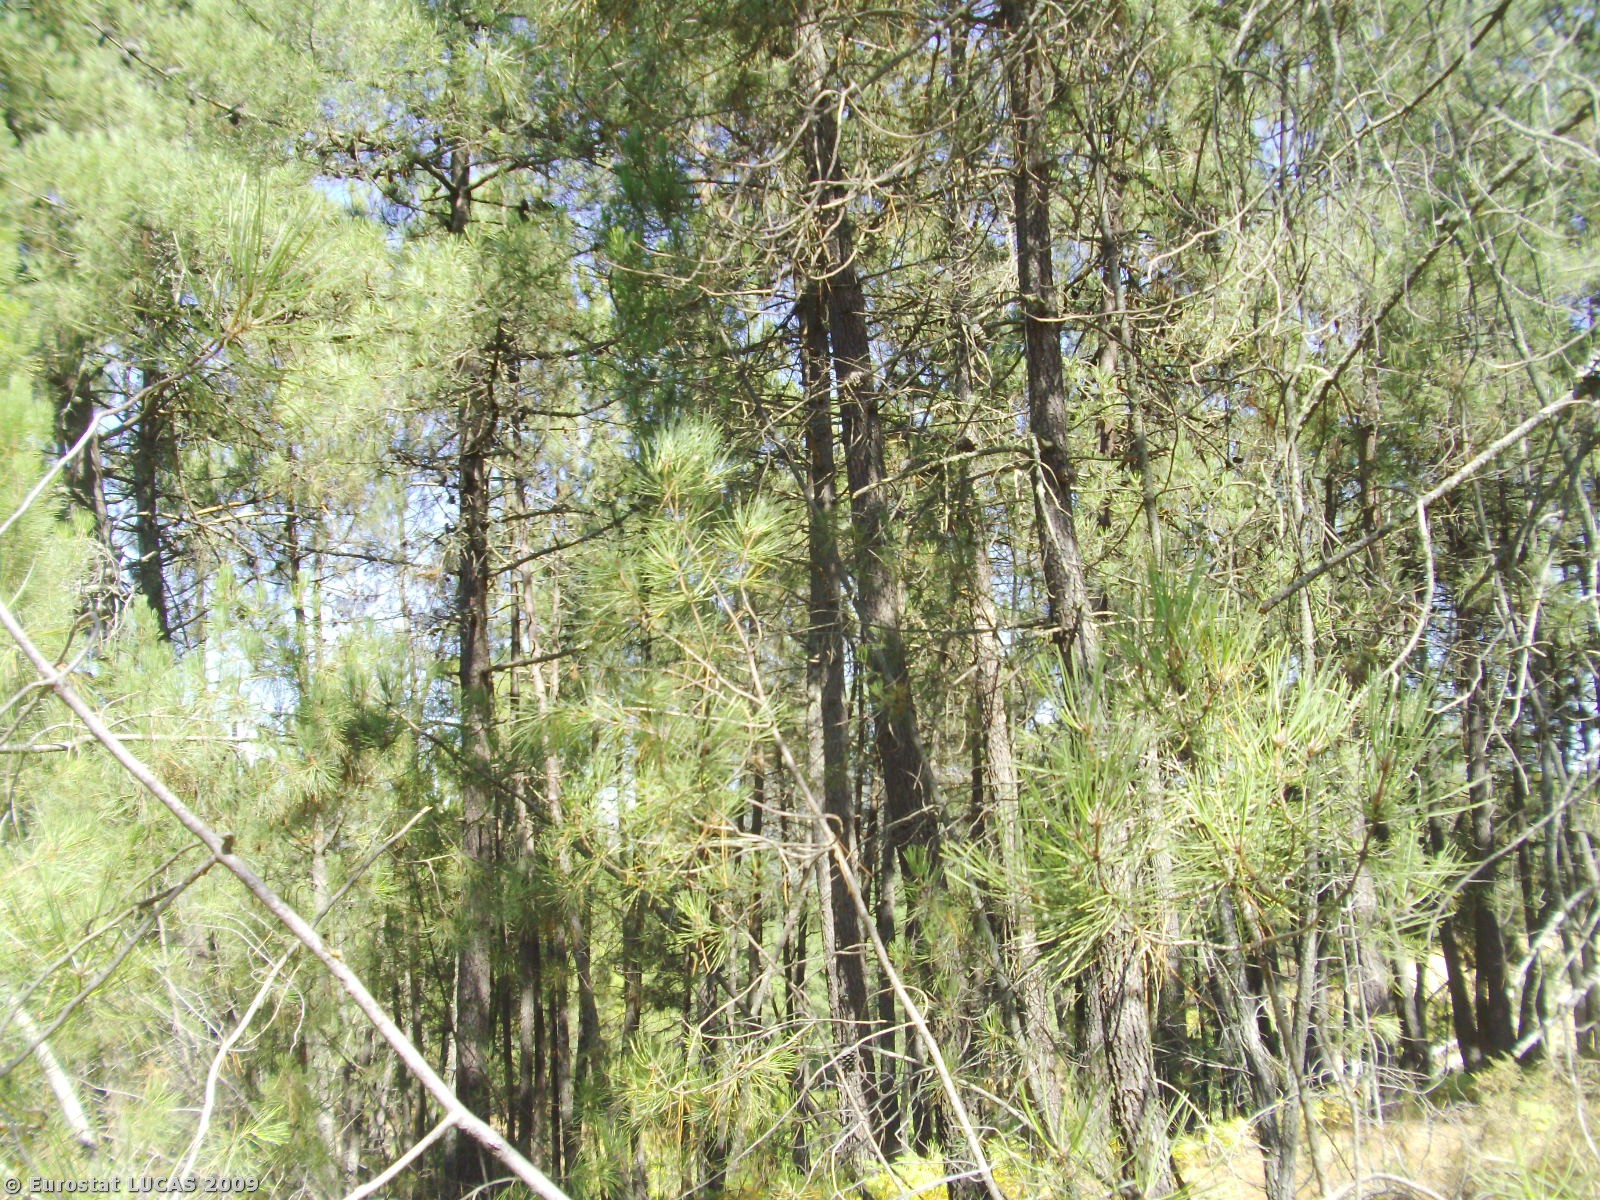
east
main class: Woodland
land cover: Coniferous woodland
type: coniferous forest of the mediterranean region
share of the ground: 50 - 75 %
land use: Forestry
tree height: > 5 m
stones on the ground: < 10 %
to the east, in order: Coniferous woodland; Bare land; Vineyards; Potatoes; Abandoned hedges; Spontaneously vegetated surfaces; Fences; Tracks; Fences; Bare land; Coniferous woodland
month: September
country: PT
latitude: 41.2538
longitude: -7.6592
